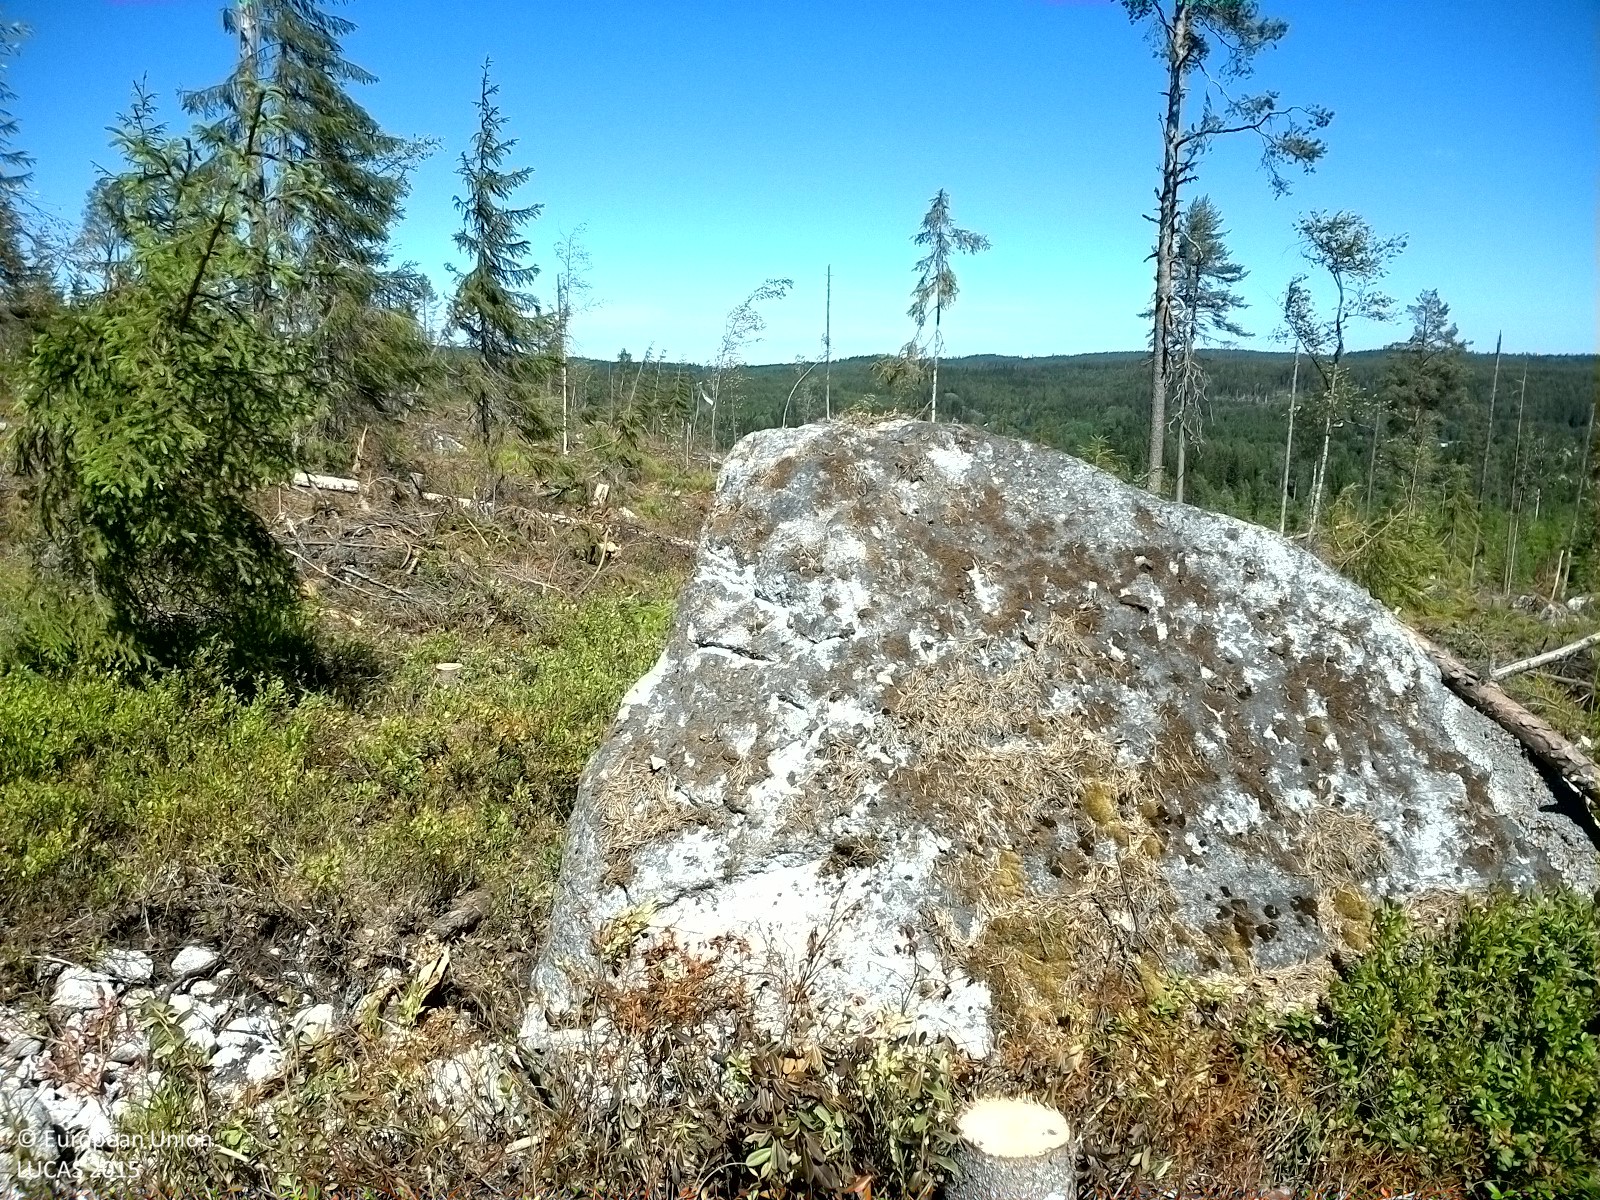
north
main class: Shrubland
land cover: Shrubland with sparse tree cover
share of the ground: 50 - 75 %
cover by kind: shrubs 55 %, unconsolidated bare surface 15 %, broadleaved forest trees 5 %
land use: Forestry
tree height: < 5 m
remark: Clear cut
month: July
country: SE
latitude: 62.2338
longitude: 16.9655
